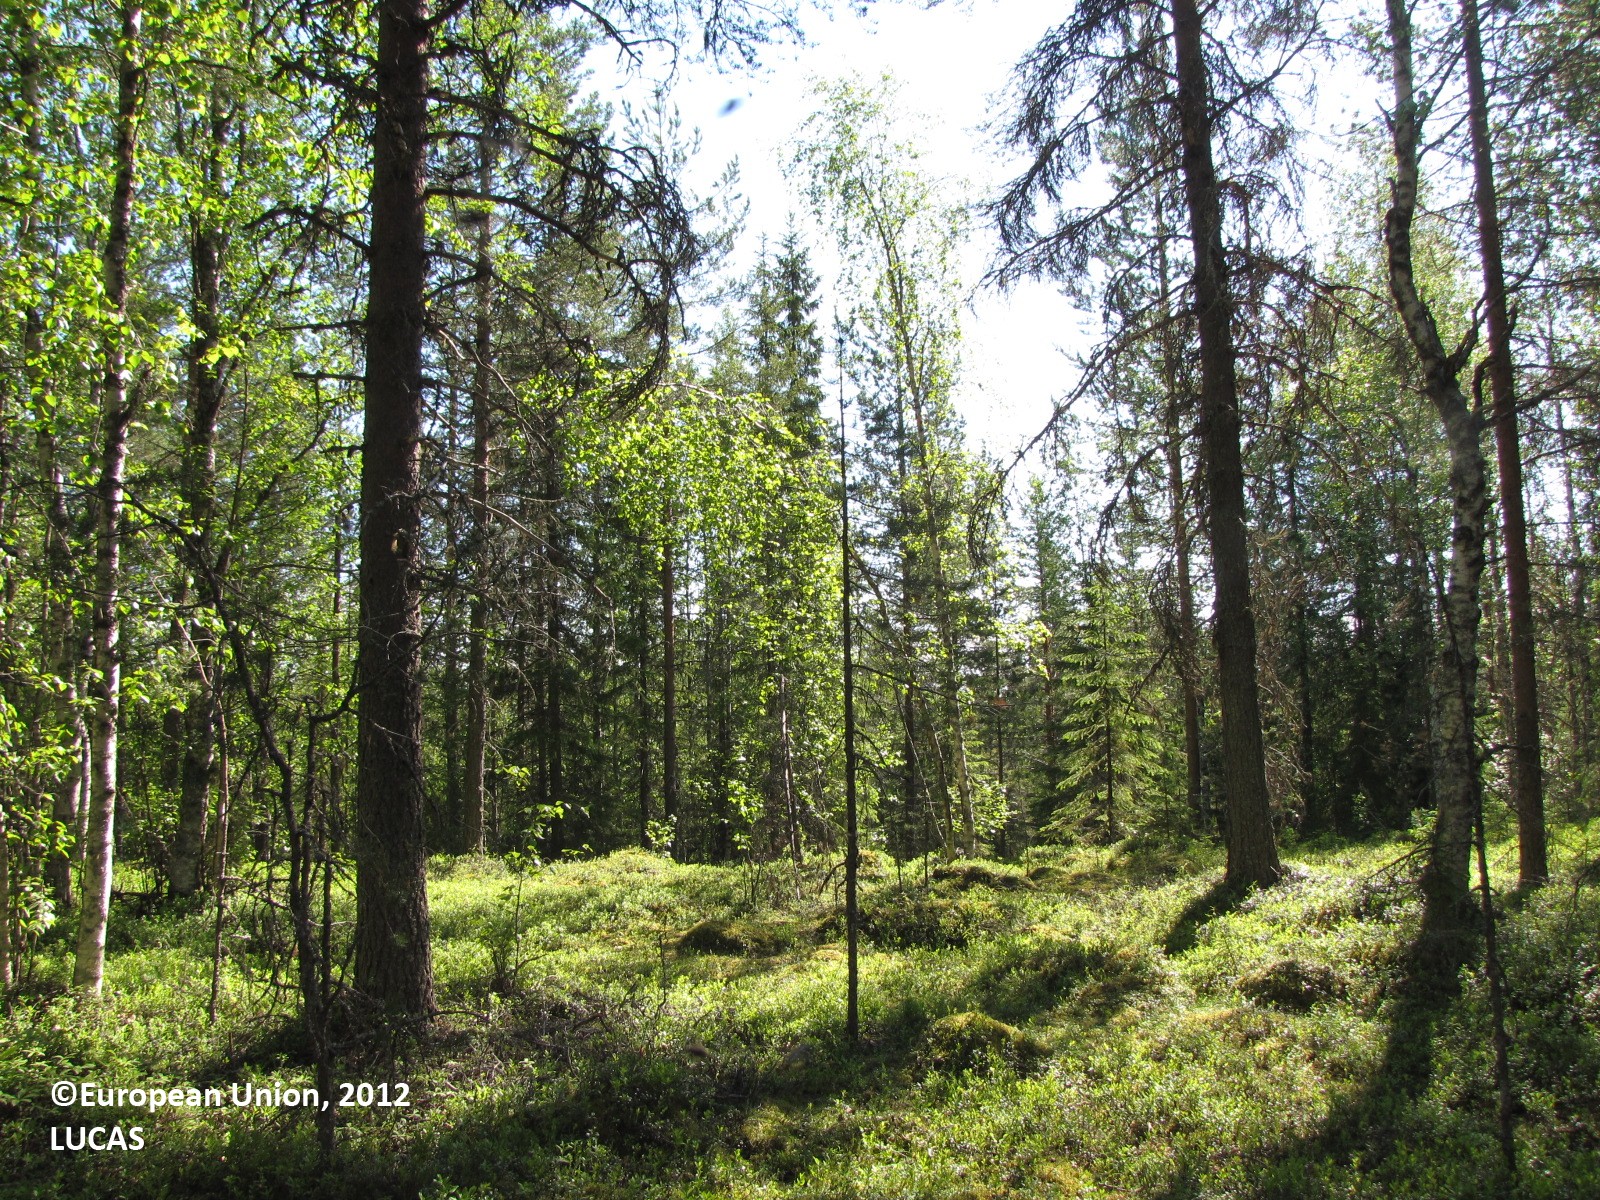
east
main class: Woodland
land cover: Pine dominated coniferous woodland
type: boreal forest
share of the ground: 50 - 75 %
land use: Forestry
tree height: > 5 m
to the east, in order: Pine dominated coniferous woodland; Pine dominated mixed woodland; Spruce dominated coniferous woodland; Ditches and canals; Spruce dominated coniferous woodland; Spruce dominated mixed woodland; Ditches and canals; Spruce dominated mixed woodland; Artificial constructions in urban areas
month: July
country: FI
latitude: 66.3704
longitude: 25.2870
